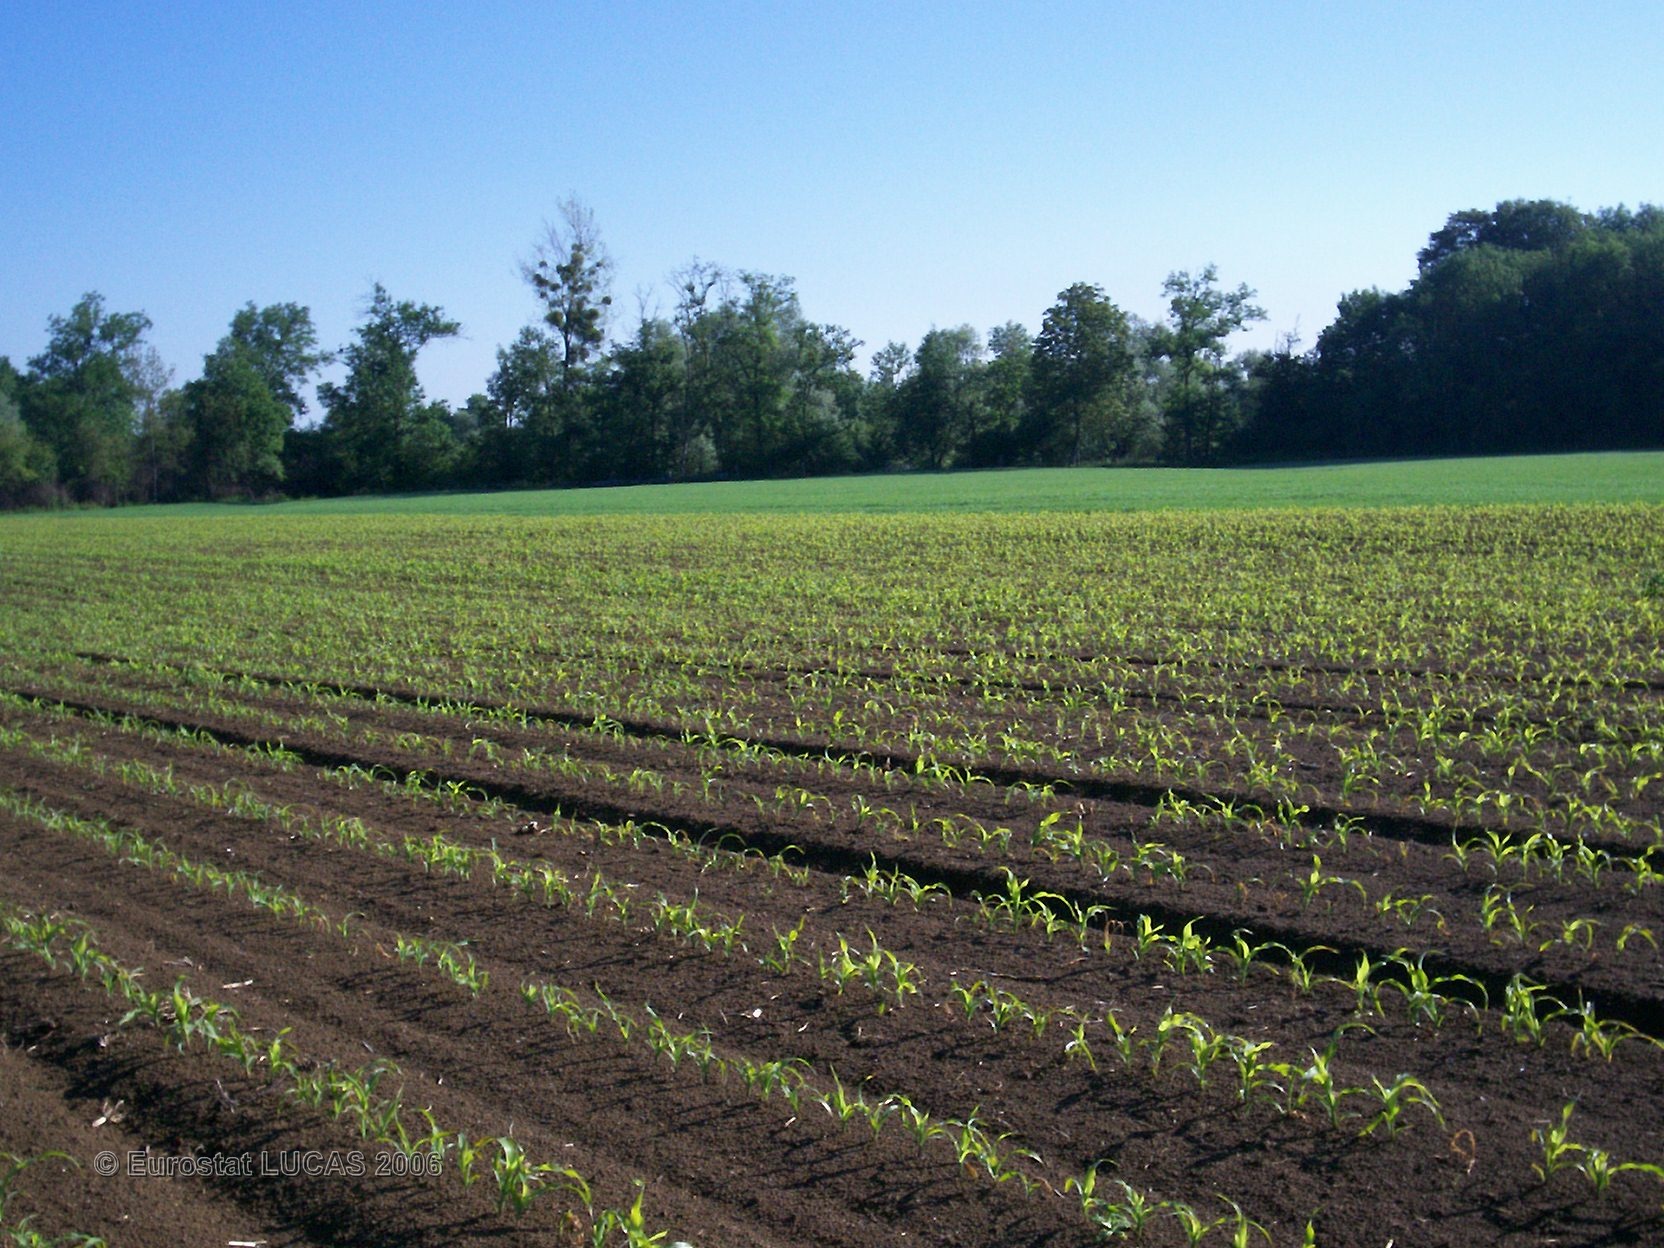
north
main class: Cropland
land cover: Maize
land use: Agriculture (excluding fallow land and kitchen gardens)
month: June
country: FR
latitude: 48.8426
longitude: 4.4783
